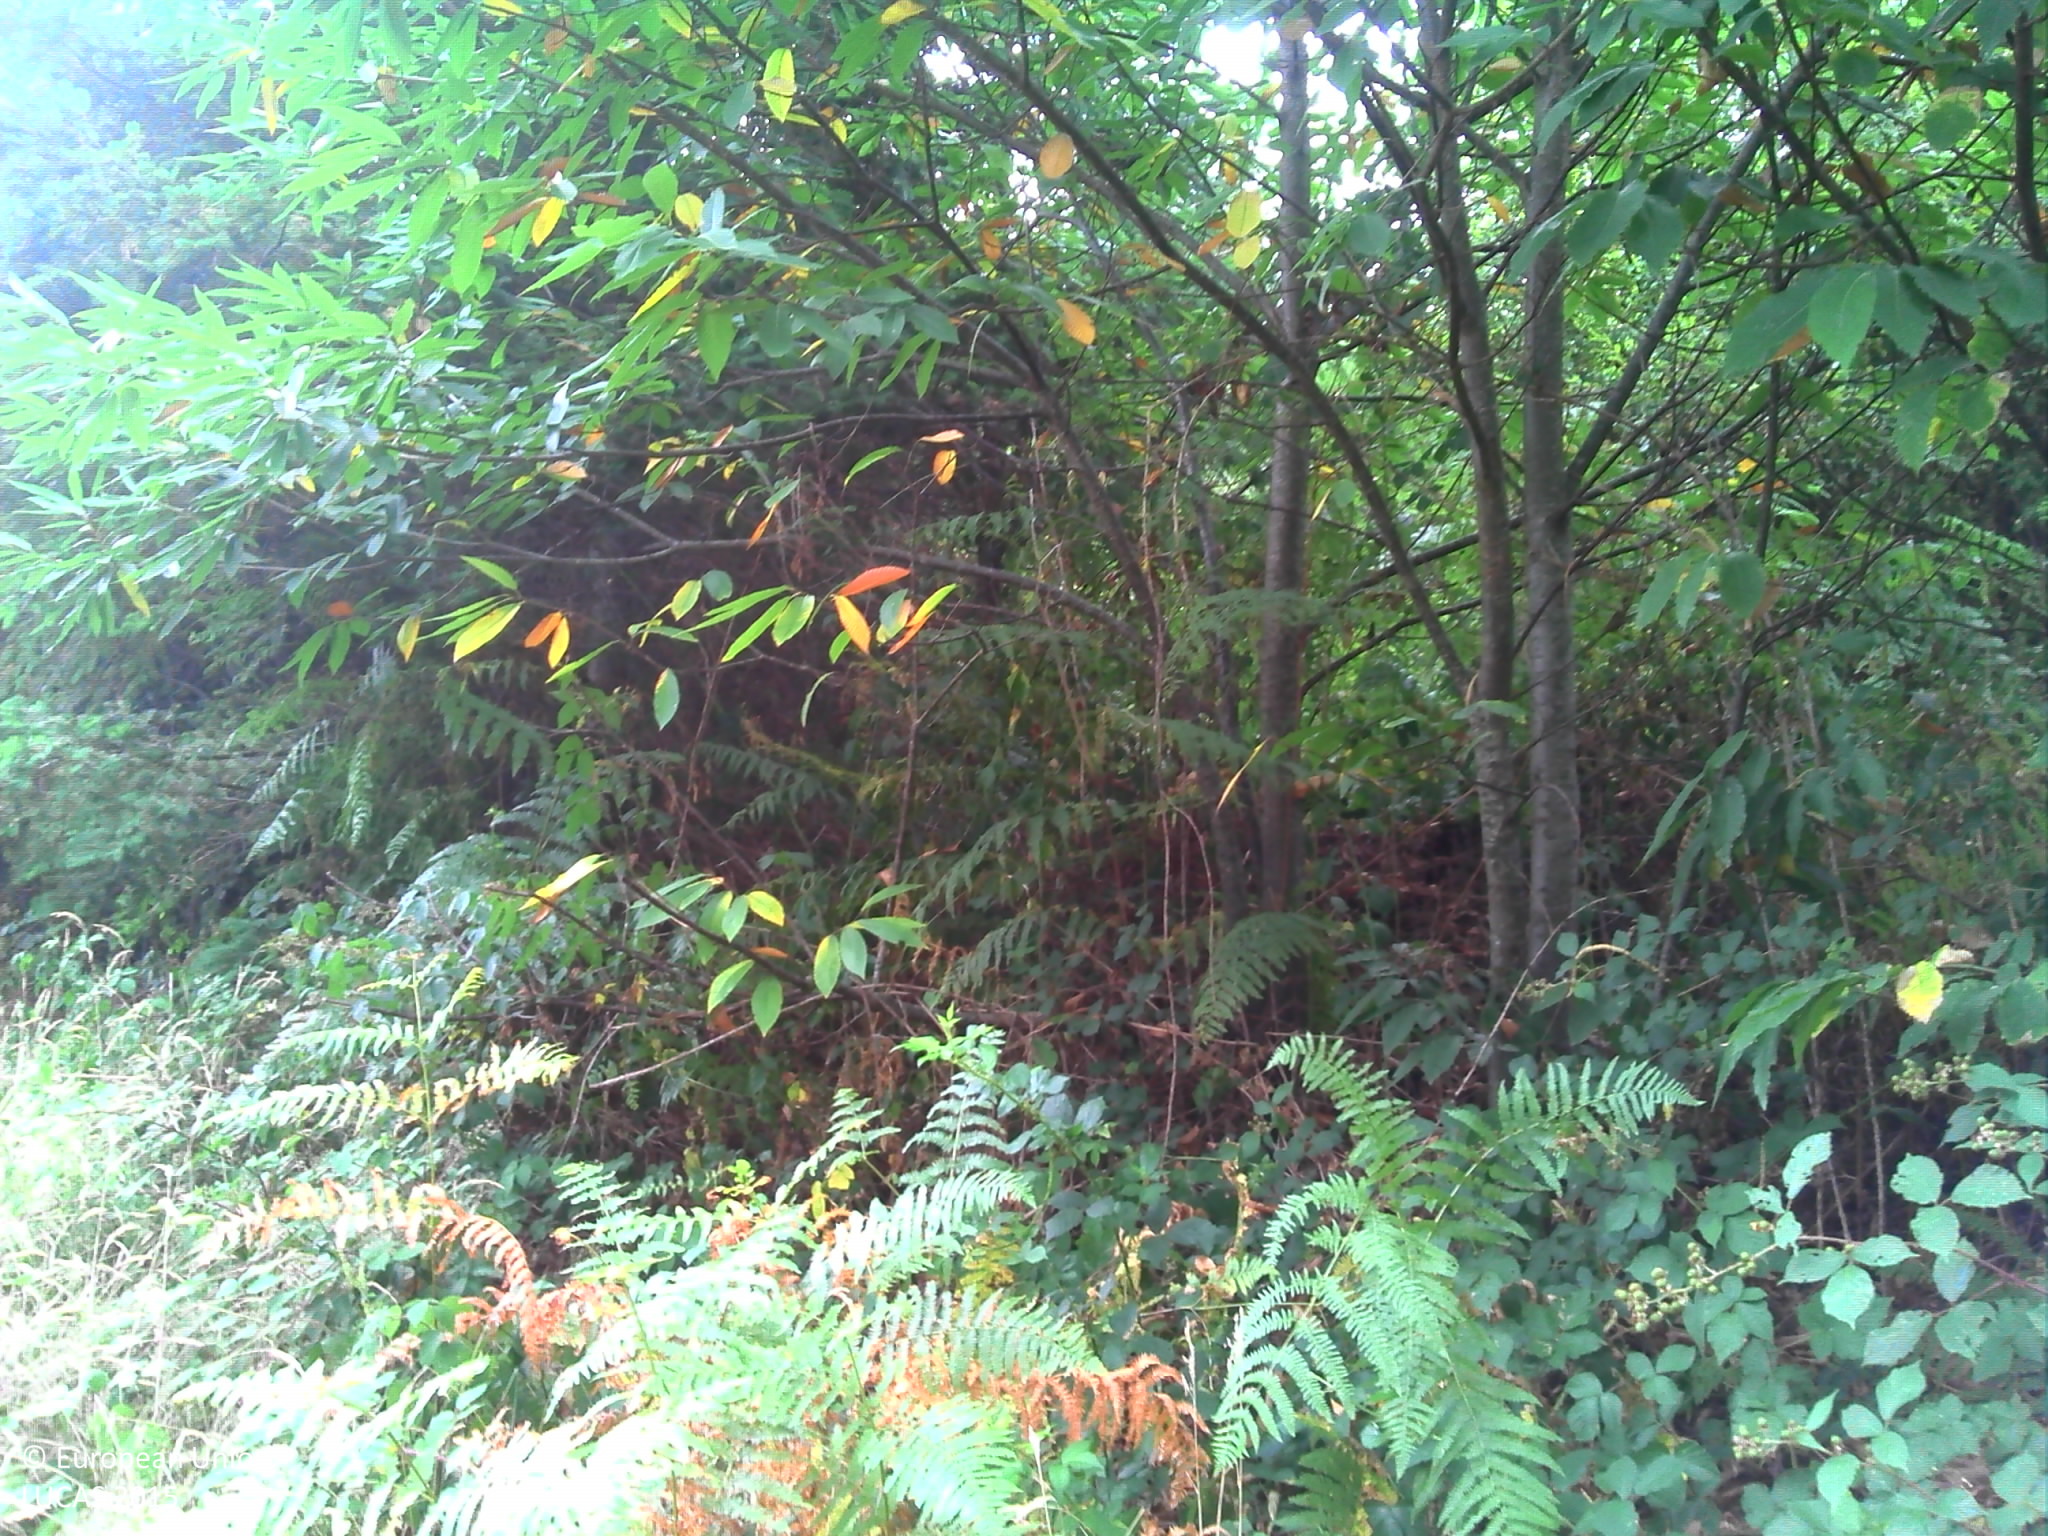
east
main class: Woodland
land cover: Spruce dominated mixed woodland
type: mesophytic deciduous forest
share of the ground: > 75 %
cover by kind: broadleaved forest trees 30 %, herbaceous plants 30 %, coniferous forest trees 20 %, lichens and mosses 20 %
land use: Forestry
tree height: > 5 m
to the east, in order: Spruce dominated mixed woodland; Grass margins; Tracks; Grass margins; Spruce dominated mixed woodland; Tracks; Spruce dominated coniferous woodland
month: July
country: FR
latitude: 45.5596
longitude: 1.0613
